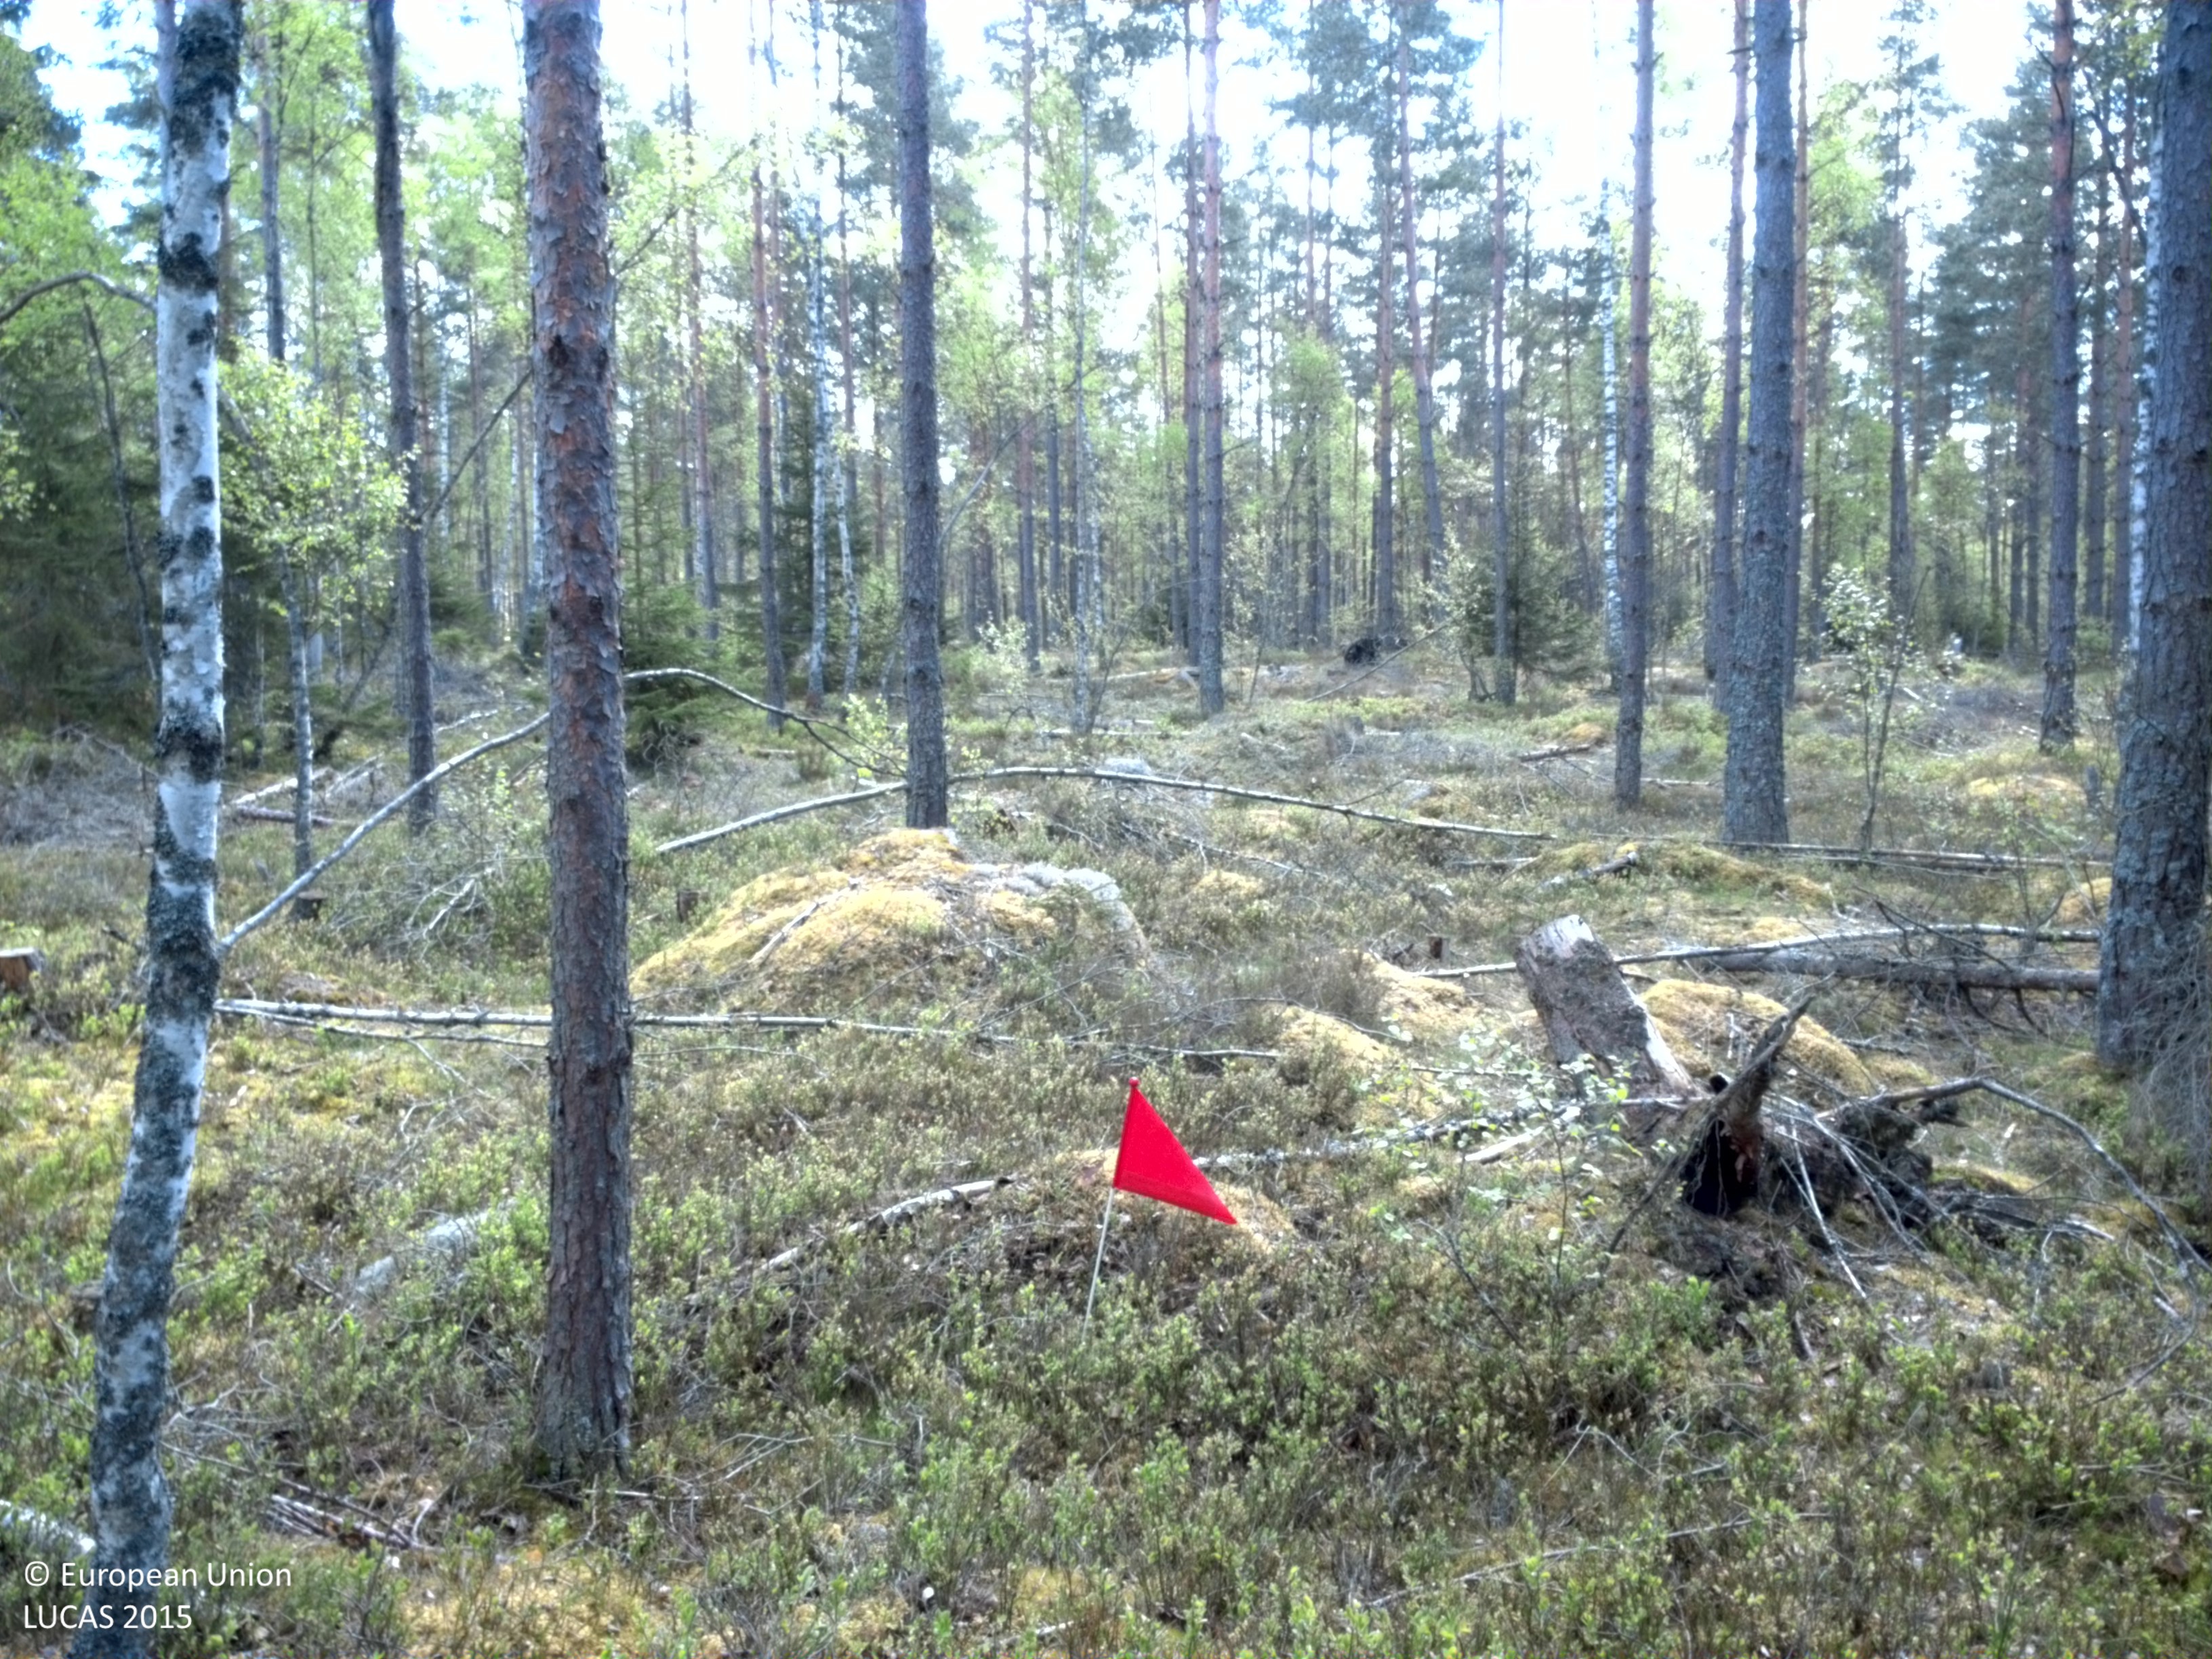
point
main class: Woodland
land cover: Pine dominated coniferous woodland
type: boreal forest
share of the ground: 25 - 50 %
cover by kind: shrubs 30 %, lichens and mosses 30 %, coniferous forest trees 25 %, herbaceous plants 10 %, broadleaved forest trees 5 %
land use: Forestry
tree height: > 5 m
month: May
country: SE
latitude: 56.7280
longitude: 15.2771
